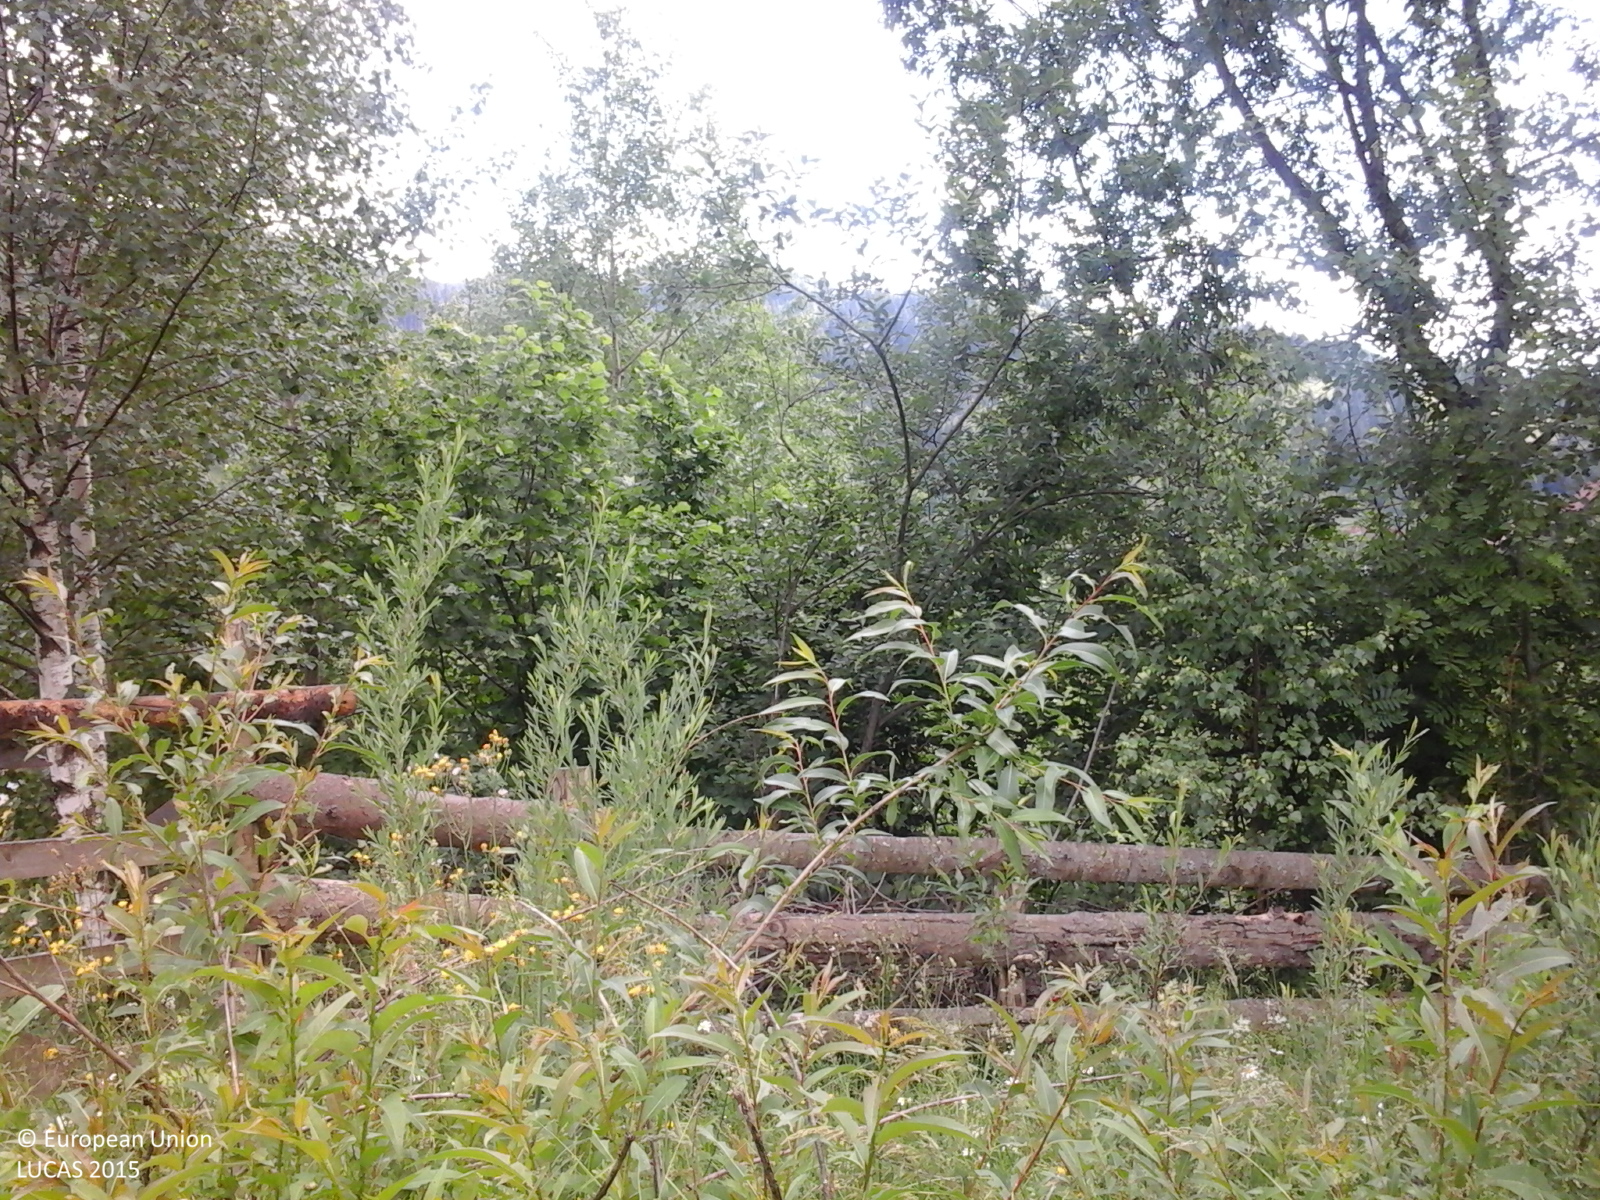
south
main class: Grassland
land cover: Grassland with sparse tree/shrub cover
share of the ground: > 75 %
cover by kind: herbaceous plants 95 %, broadleaved forest trees 5 %
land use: Agriculture (excluding fallow land and kitchen gardens)
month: June
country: RO
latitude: 47.5391
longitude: 25.3779
